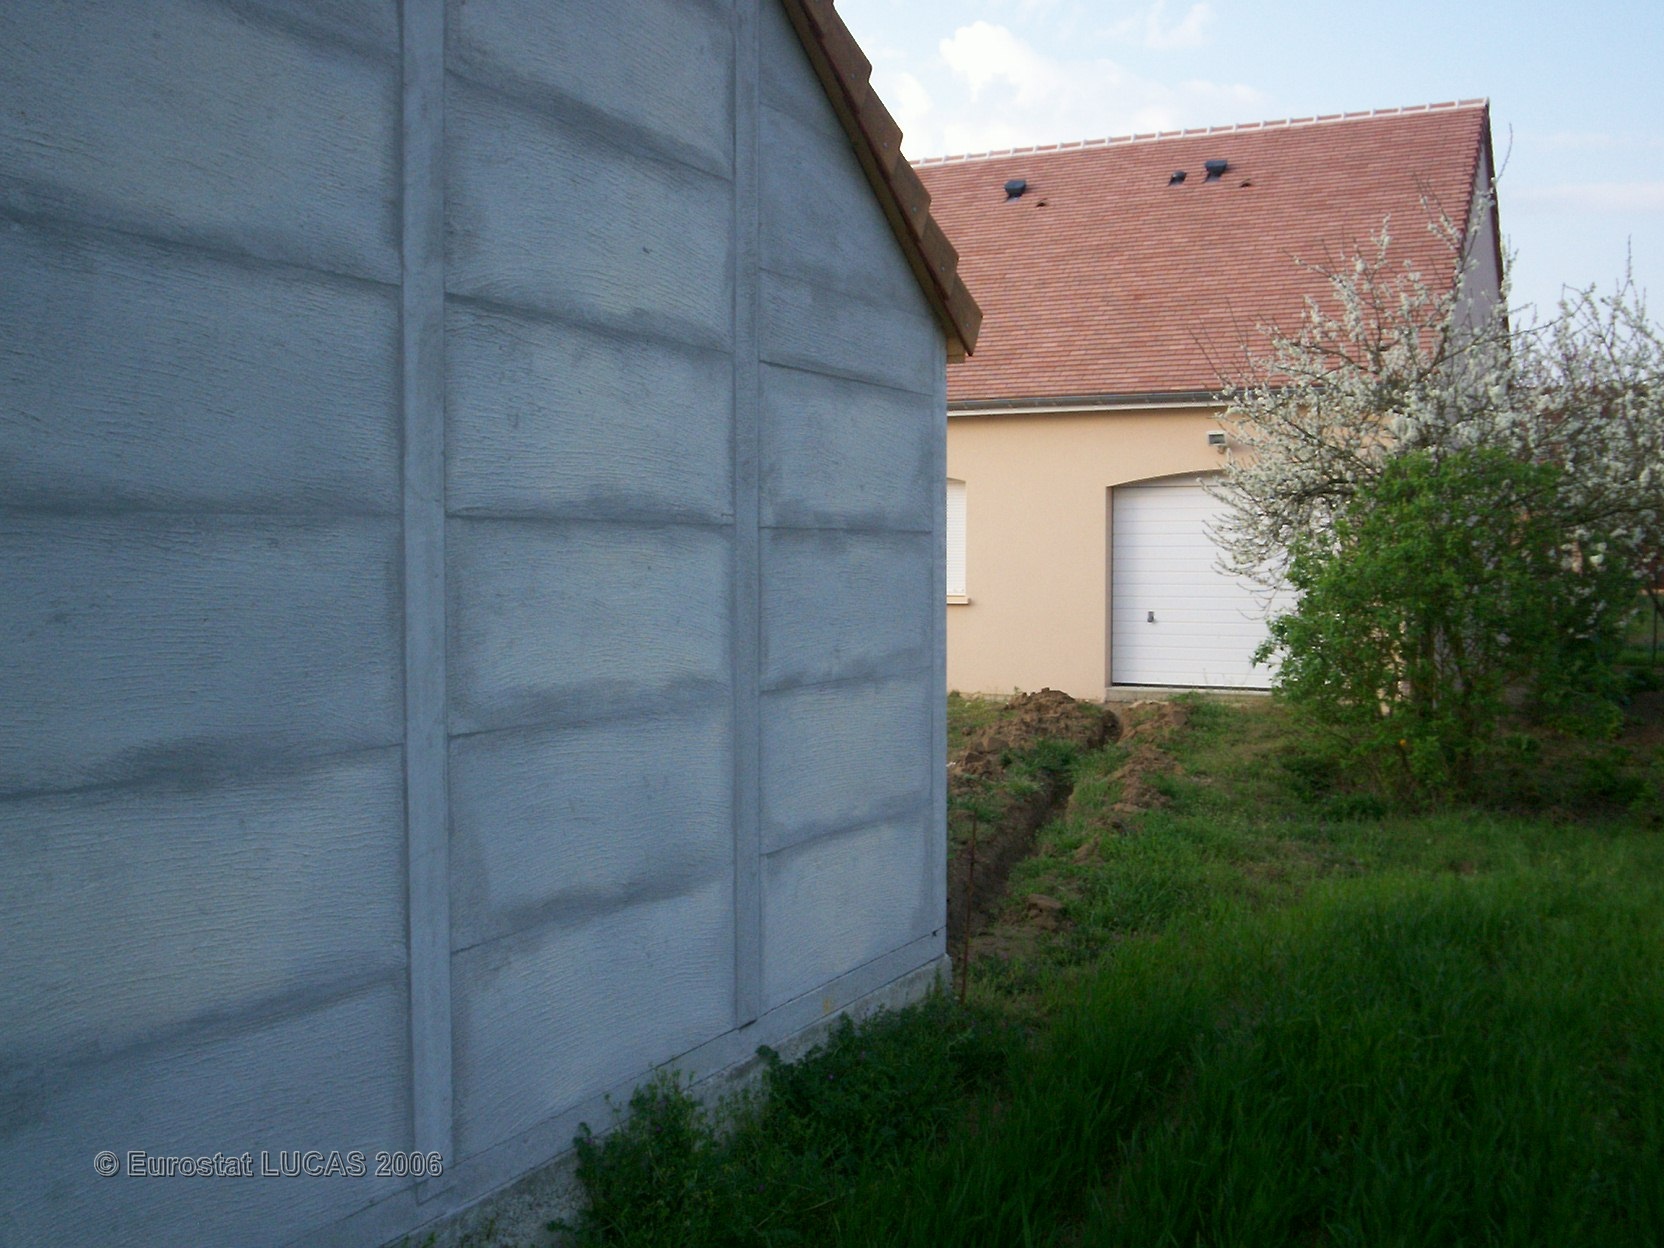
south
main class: Cropland
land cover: Common wheat
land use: Agriculture (excluding fallow land and kitchen gardens)
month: April
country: FR
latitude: 48.1449
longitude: 0.3653
